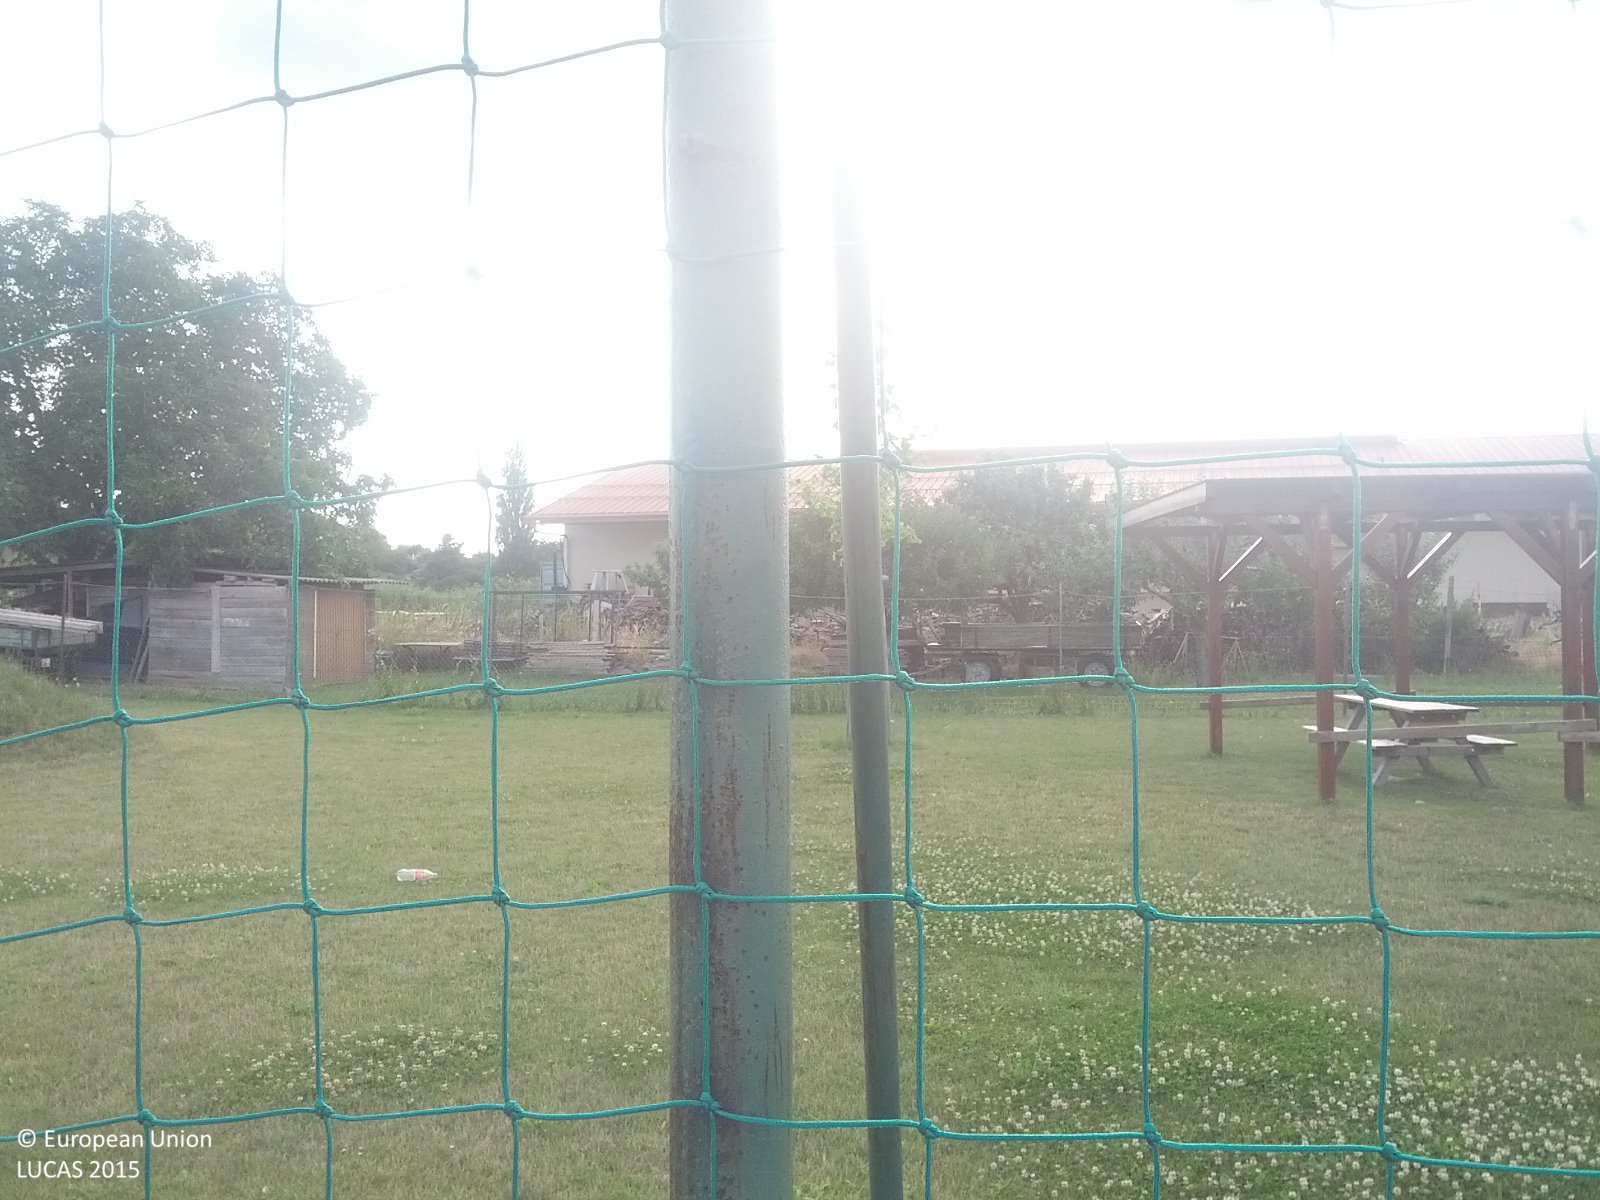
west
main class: Grassland
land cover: Grassland without tree/shrub cover
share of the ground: > 75 %
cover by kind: herbaceous plants 95 %, unconsolidated bare surface 5 %
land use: Sport
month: July
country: AT
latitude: 48.3584
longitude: 16.4703
